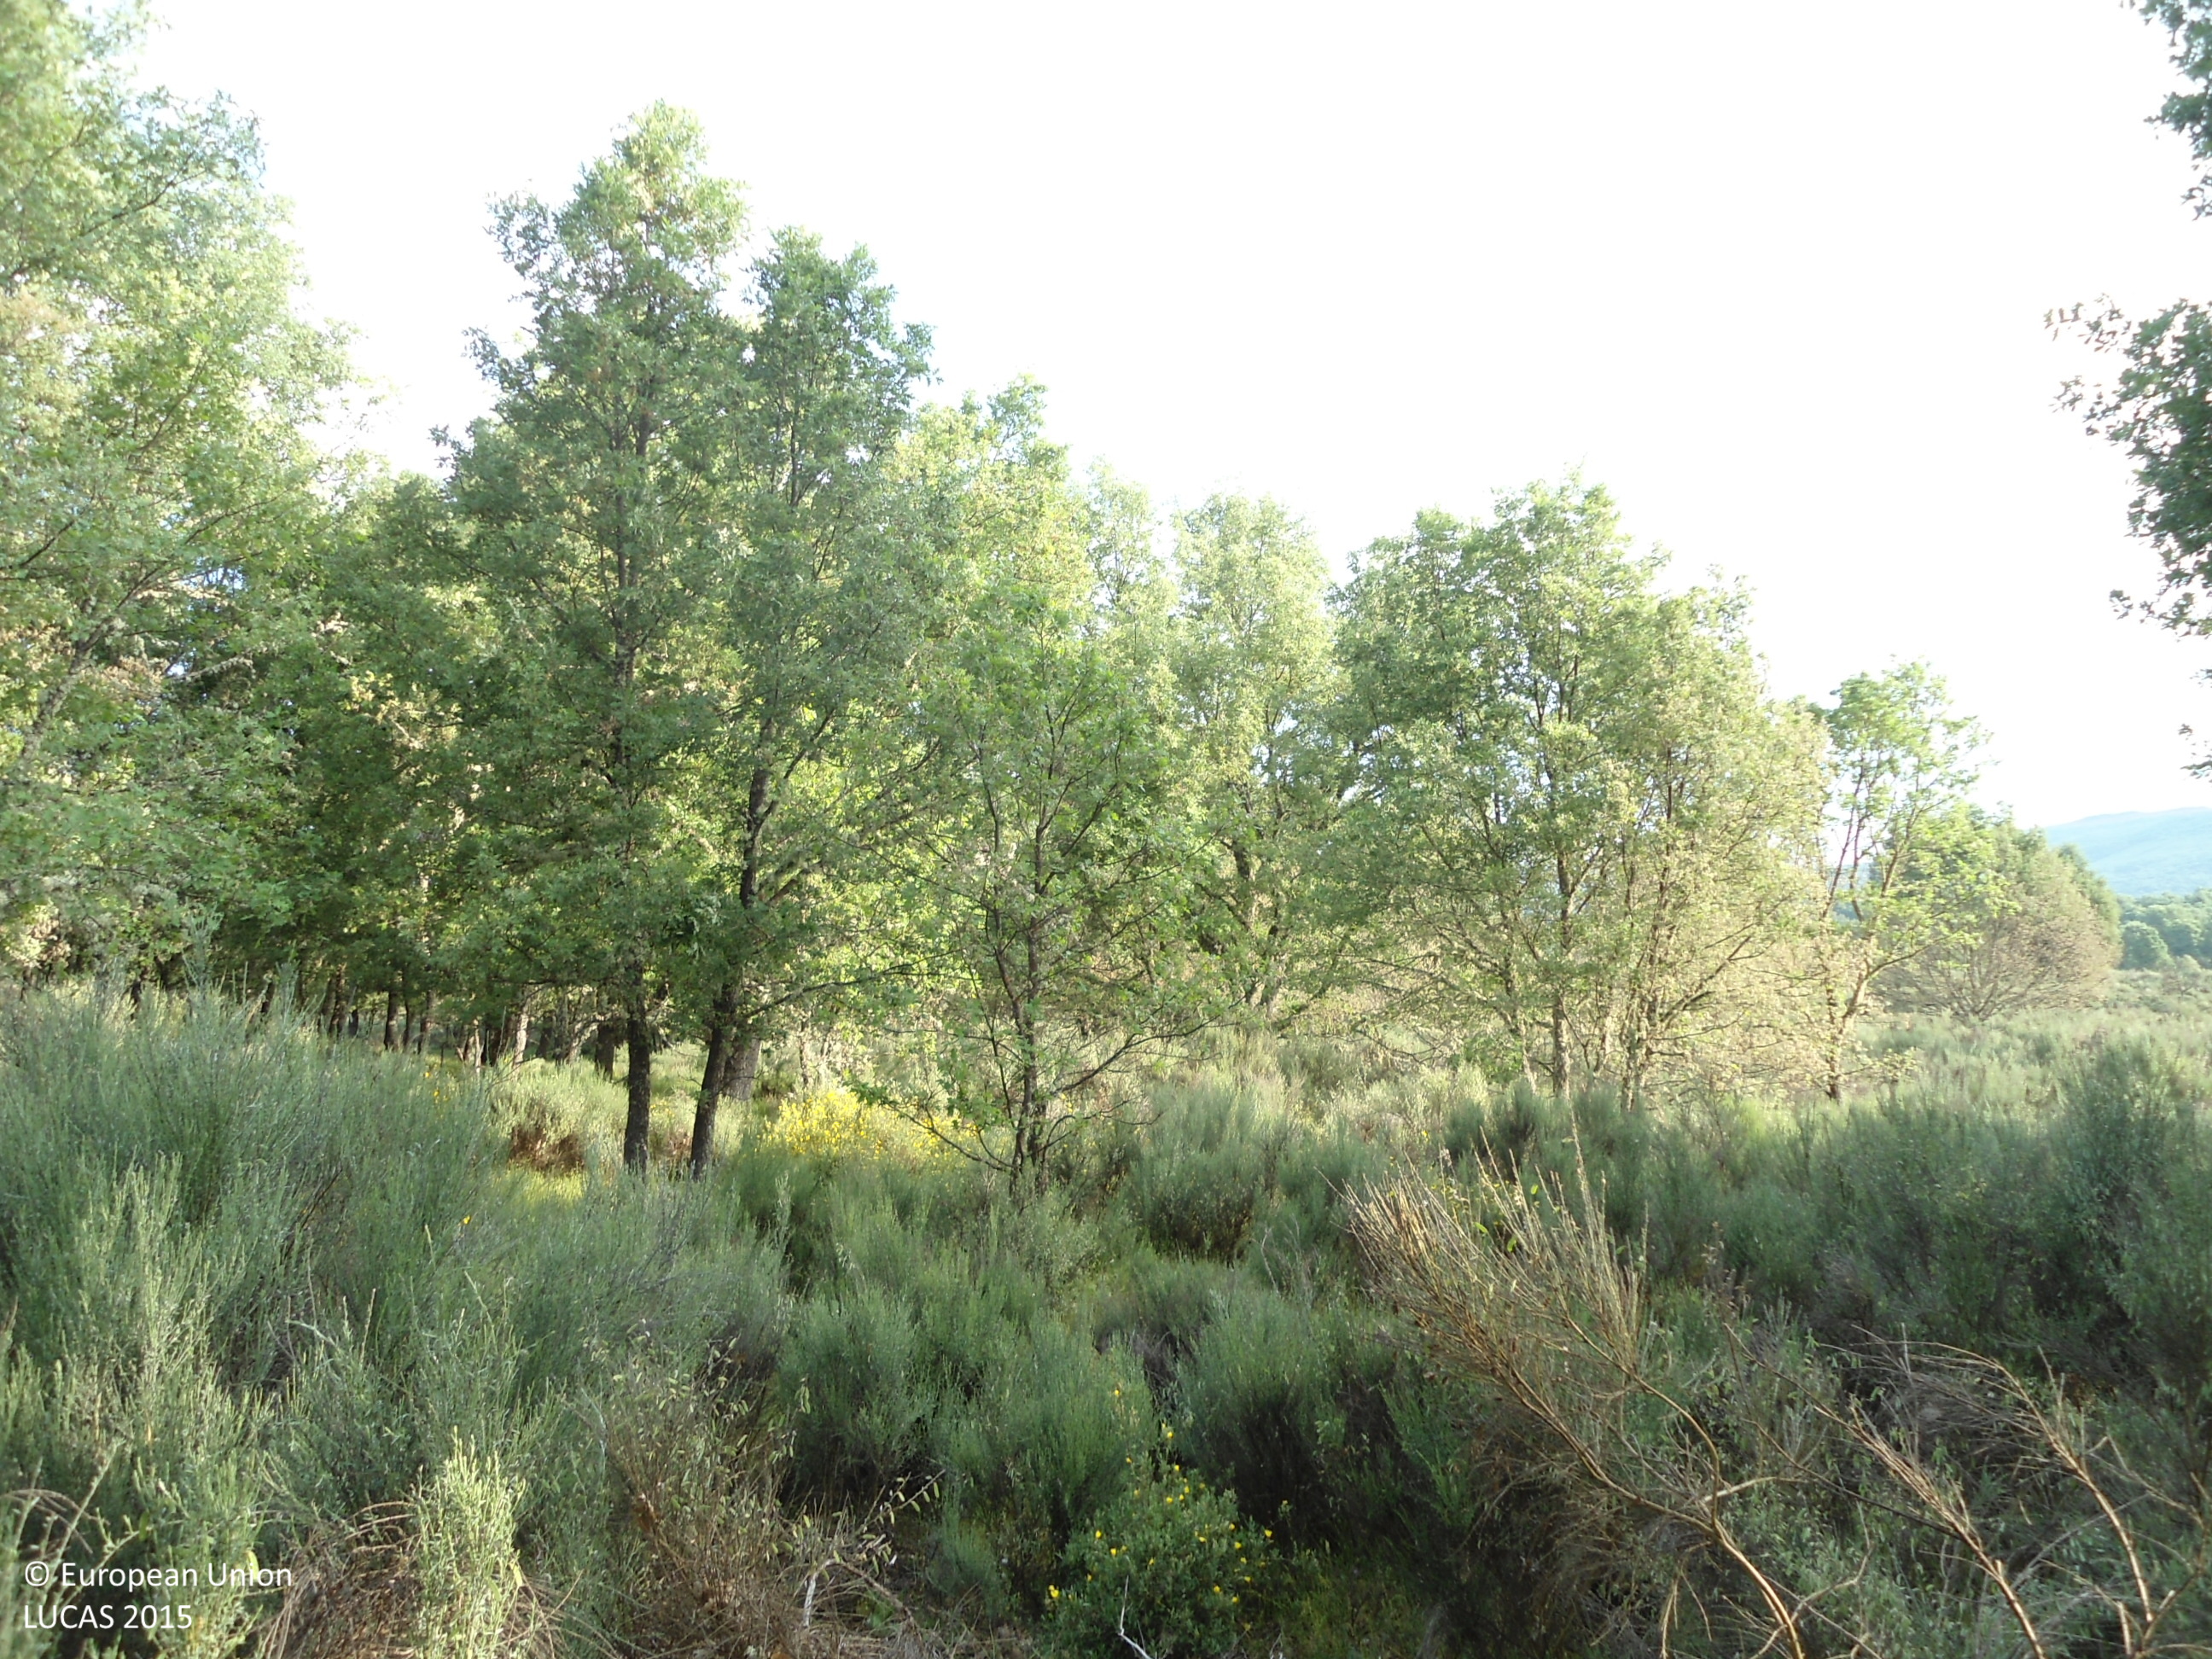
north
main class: Woodland
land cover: Broadleaved woodland
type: broadleaved evergreen forest
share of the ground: > 75 %
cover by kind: broadleaved forest trees 75 %, shrubs 20 %, herbaceous plants 5 %
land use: Forestry
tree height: > 5 m
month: June
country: ES
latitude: 42.0627
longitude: -6.6088
